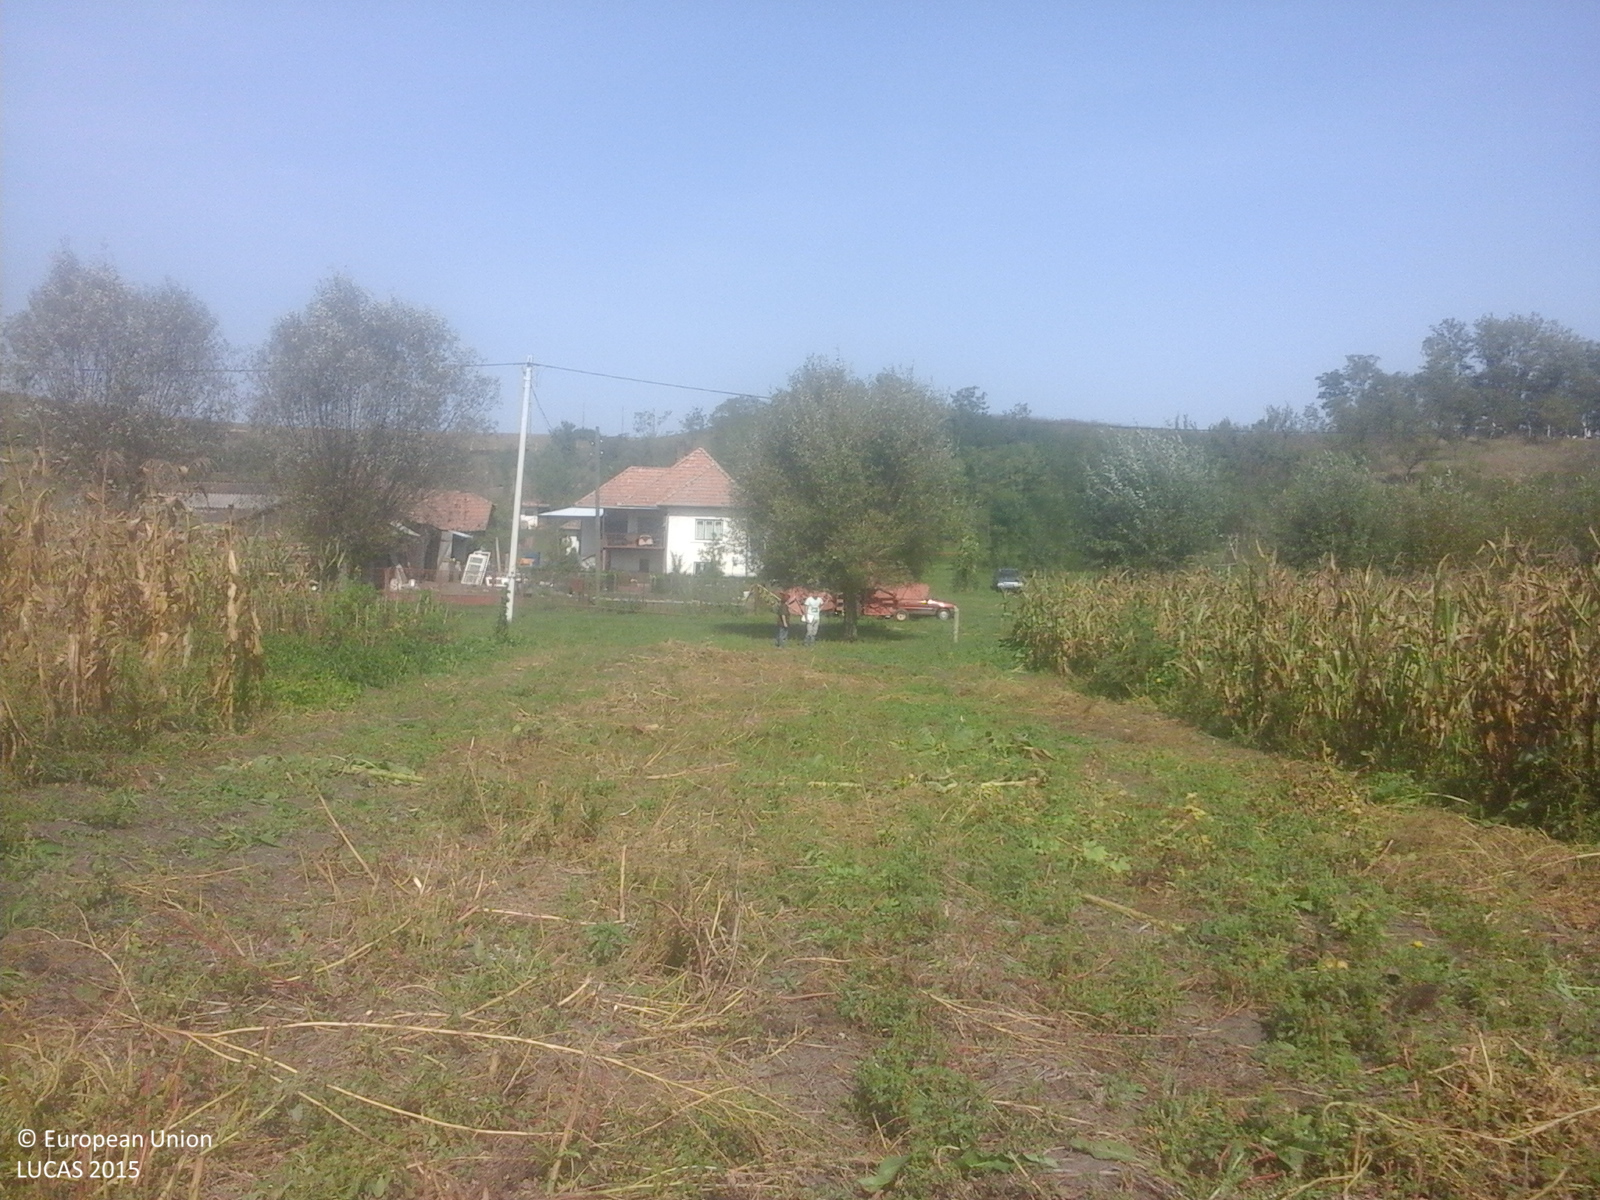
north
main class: Cropland
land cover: Potatoes
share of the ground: 50 - 75 %
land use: Agriculture (excluding fallow land and kitchen gardens)
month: September
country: RO
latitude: 46.7957
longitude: 24.4067
